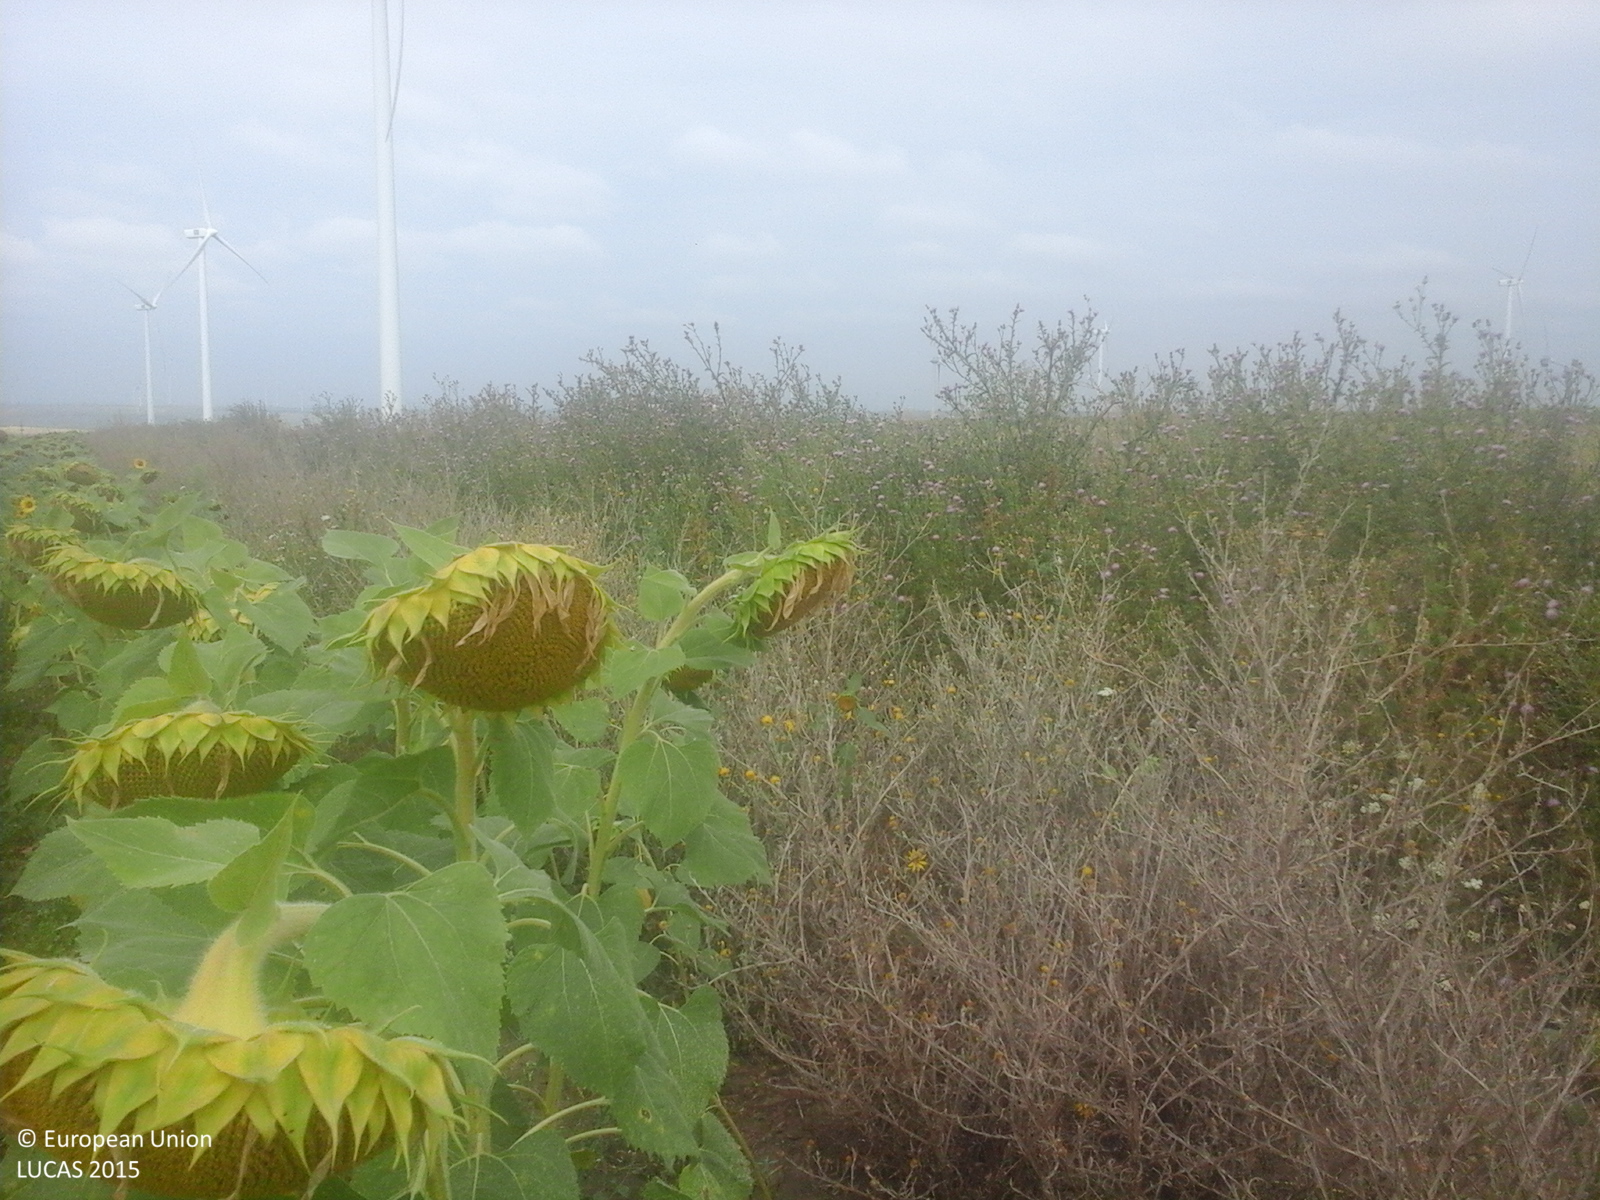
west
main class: Cropland
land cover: Sunflower
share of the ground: > 75 %
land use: Agriculture (excluding fallow land and kitchen gardens)
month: August
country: RO
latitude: 44.7857
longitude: 28.3337
